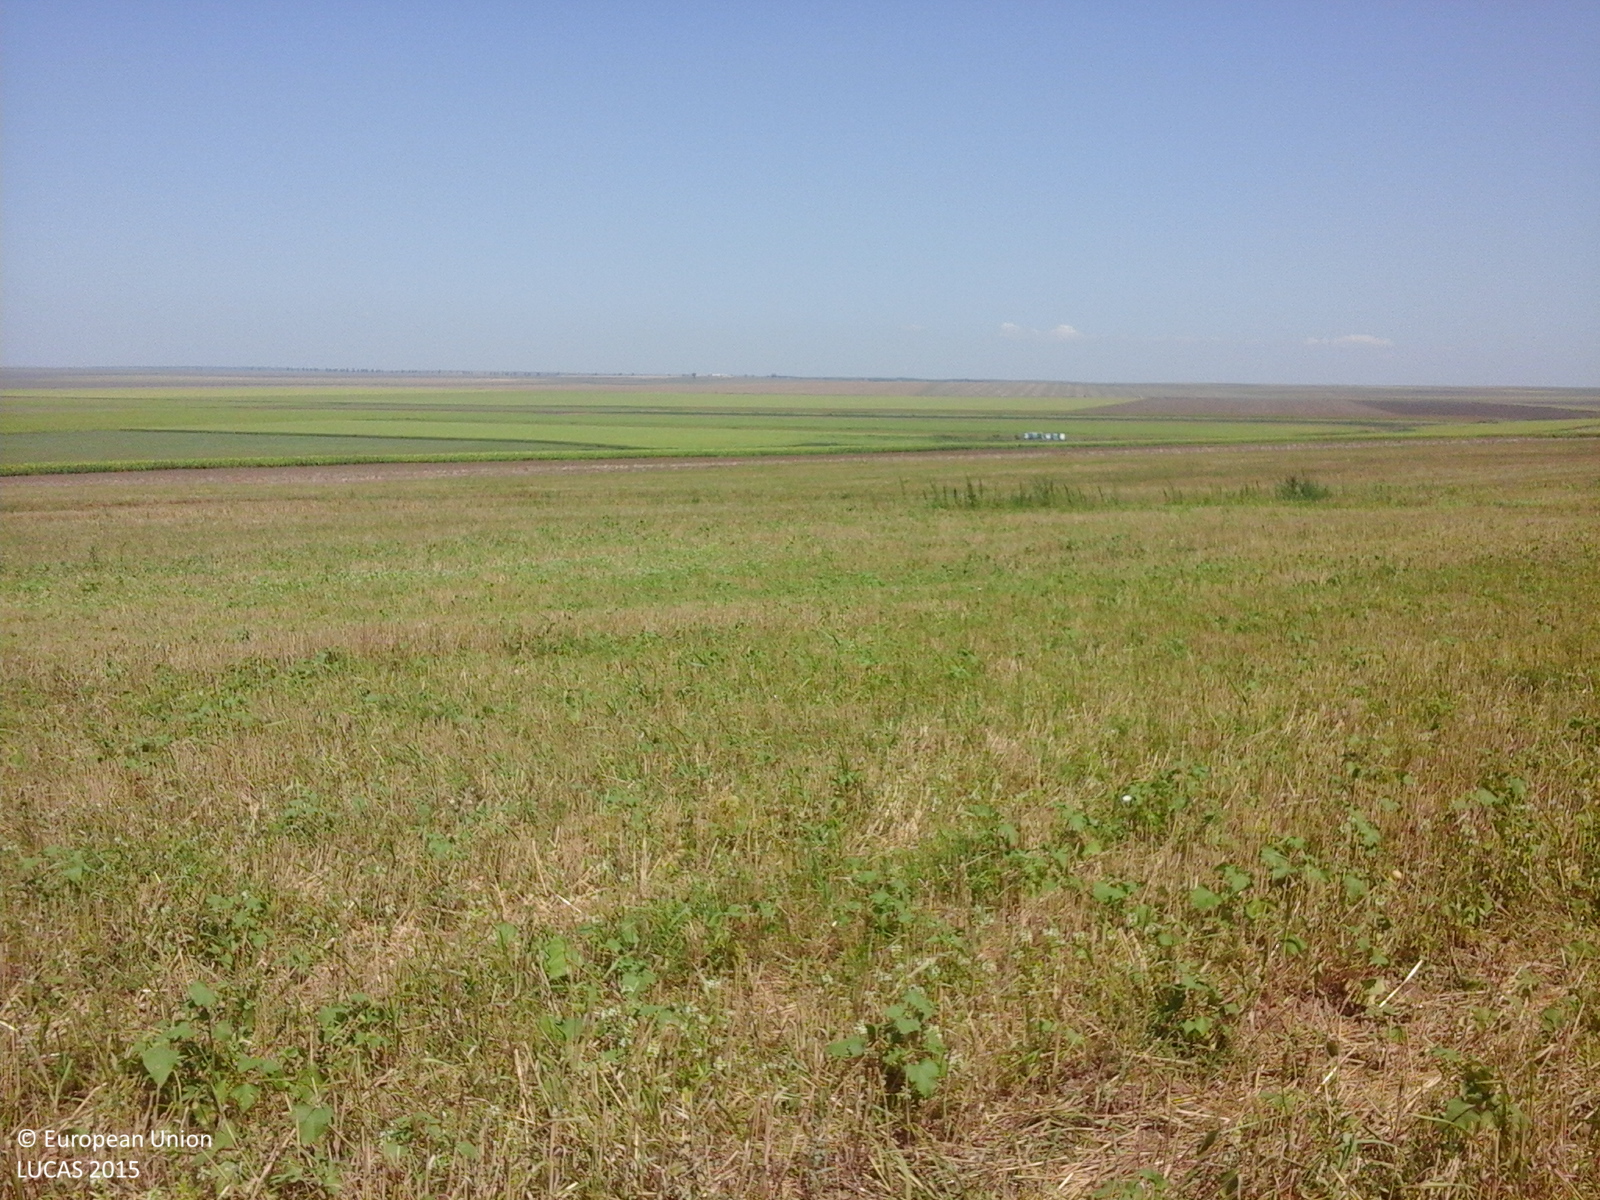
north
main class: Cropland
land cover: Common wheat
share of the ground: > 75 %
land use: Agriculture (excluding fallow land and kitchen gardens)
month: August
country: RO
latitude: 44.6285
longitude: 28.4896
